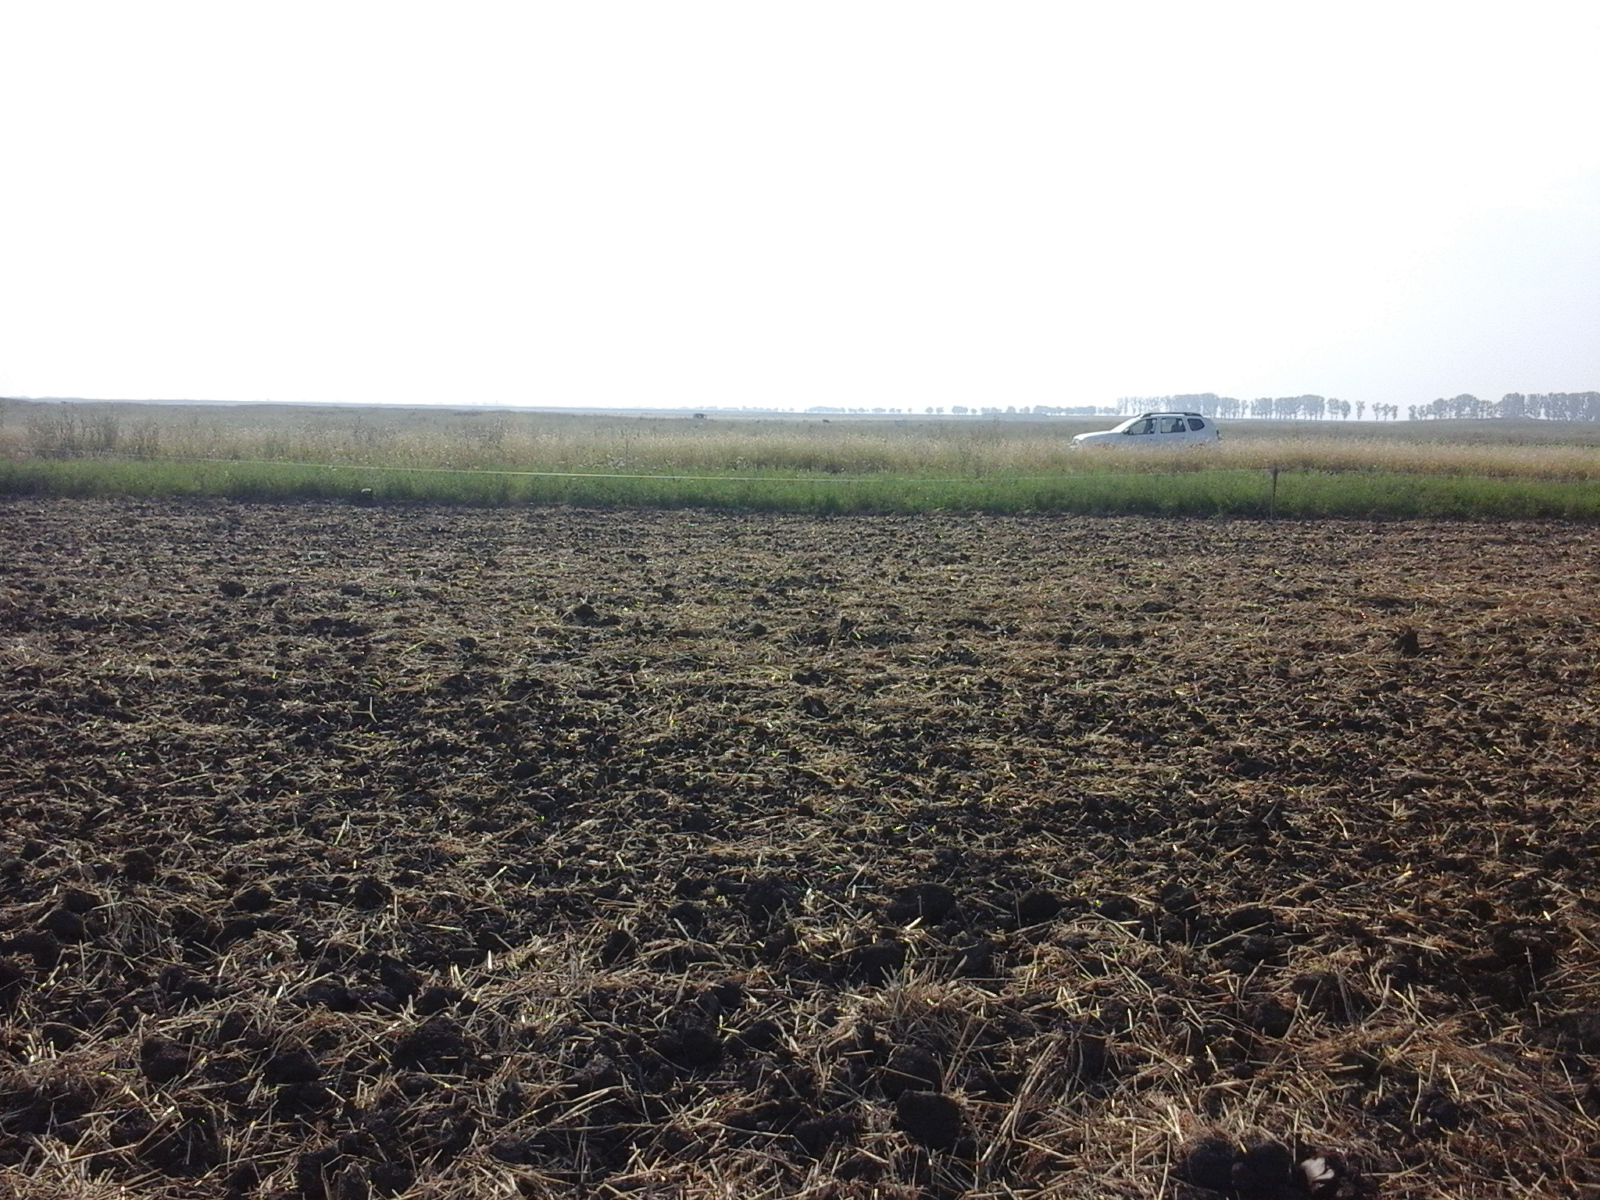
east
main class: Cropland
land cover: Common wheat
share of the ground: 50 - 75 %
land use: Agriculture (excluding fallow land and kitchen gardens)
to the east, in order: Common wheat; Fences; Grassland without tree/shrub cover; Ditches and canals; Grassland without tree/shrub cover; Tracks; Grassland without tree/shrub cover; Spontaneously vegetated surfaces; Ditches and canals; Spontaneously vegetated surfaces
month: August
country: RO
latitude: 44.0140
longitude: 23.4832
